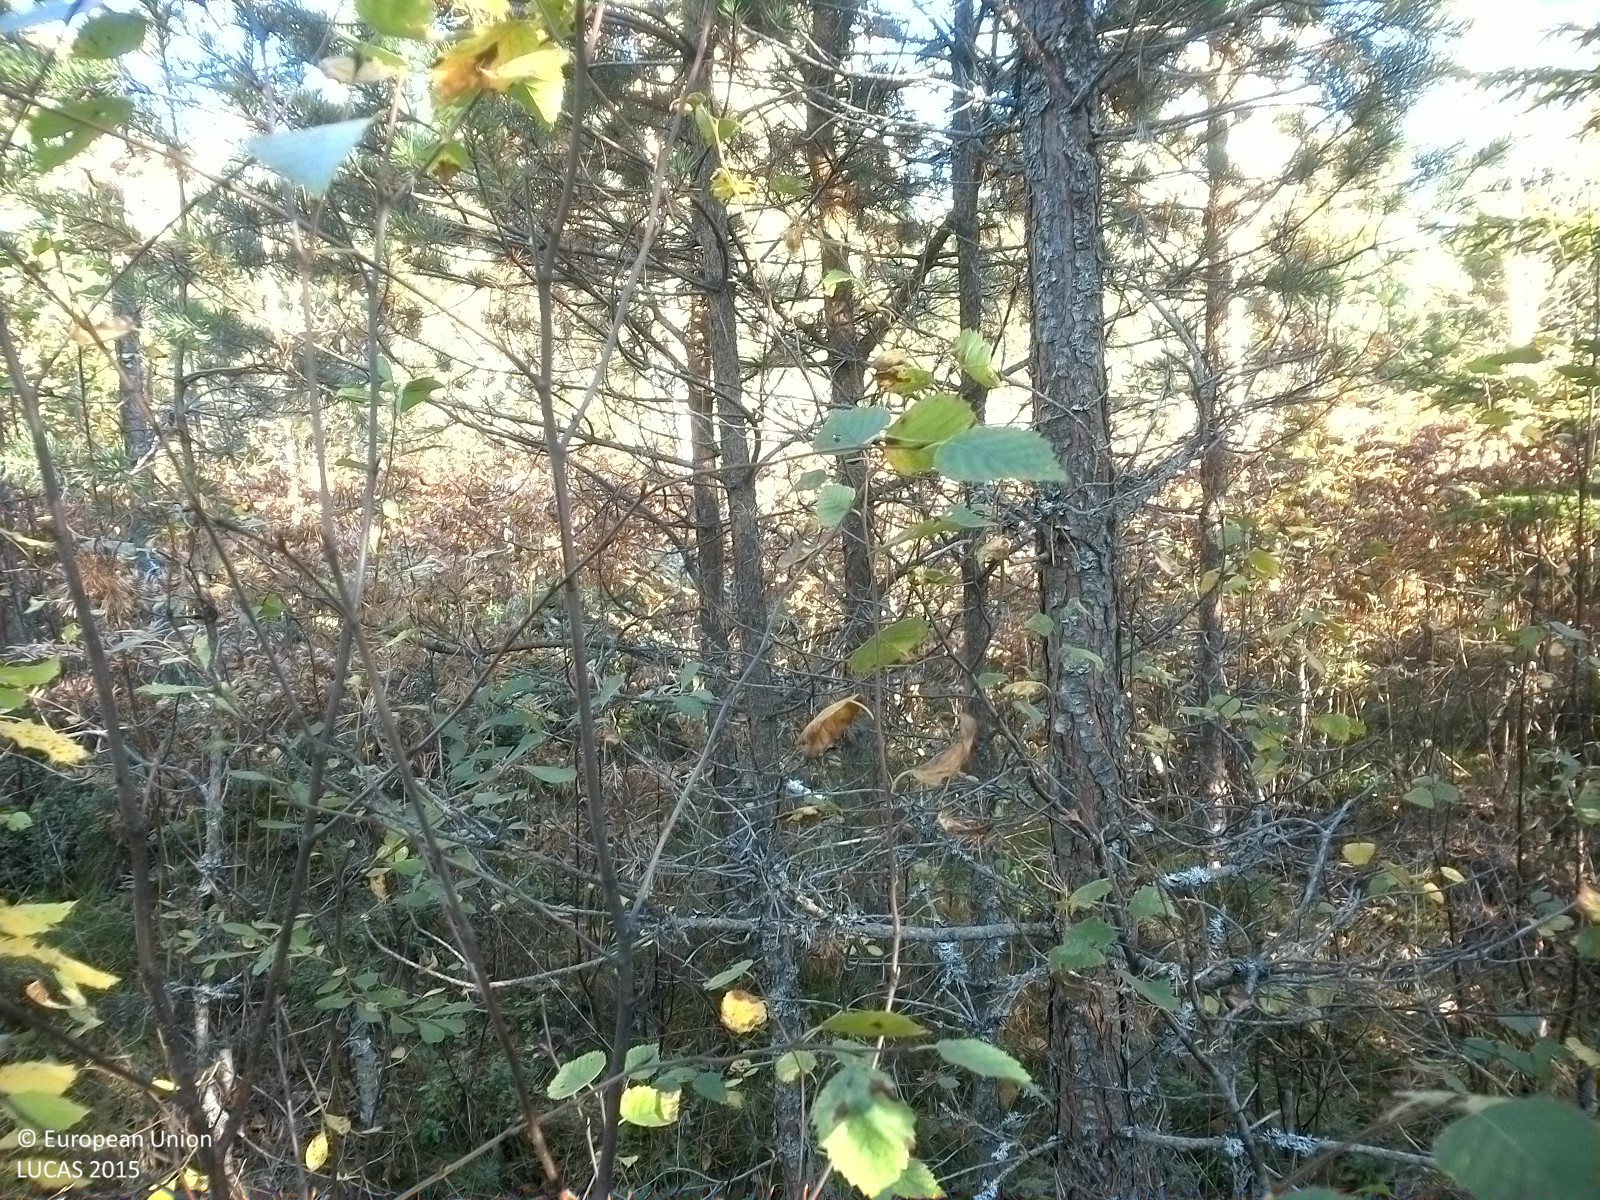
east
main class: Woodland
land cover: Pine dominated coniferous woodland
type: boreal forest
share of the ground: 50 - 75 %
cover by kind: coniferous forest trees 55 %, herbaceous plants 20 %, shrubs 15 %, broadleaved forest trees 5 %, lichens and mosses 5 %
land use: Forestry
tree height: < 5 m
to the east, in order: Pine dominated coniferous woodland; Other mixed woodland; Shrubland with sparse tree cover; Pine dominated coniferous woodland
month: September
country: SE
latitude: 58.7904
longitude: 15.5474
